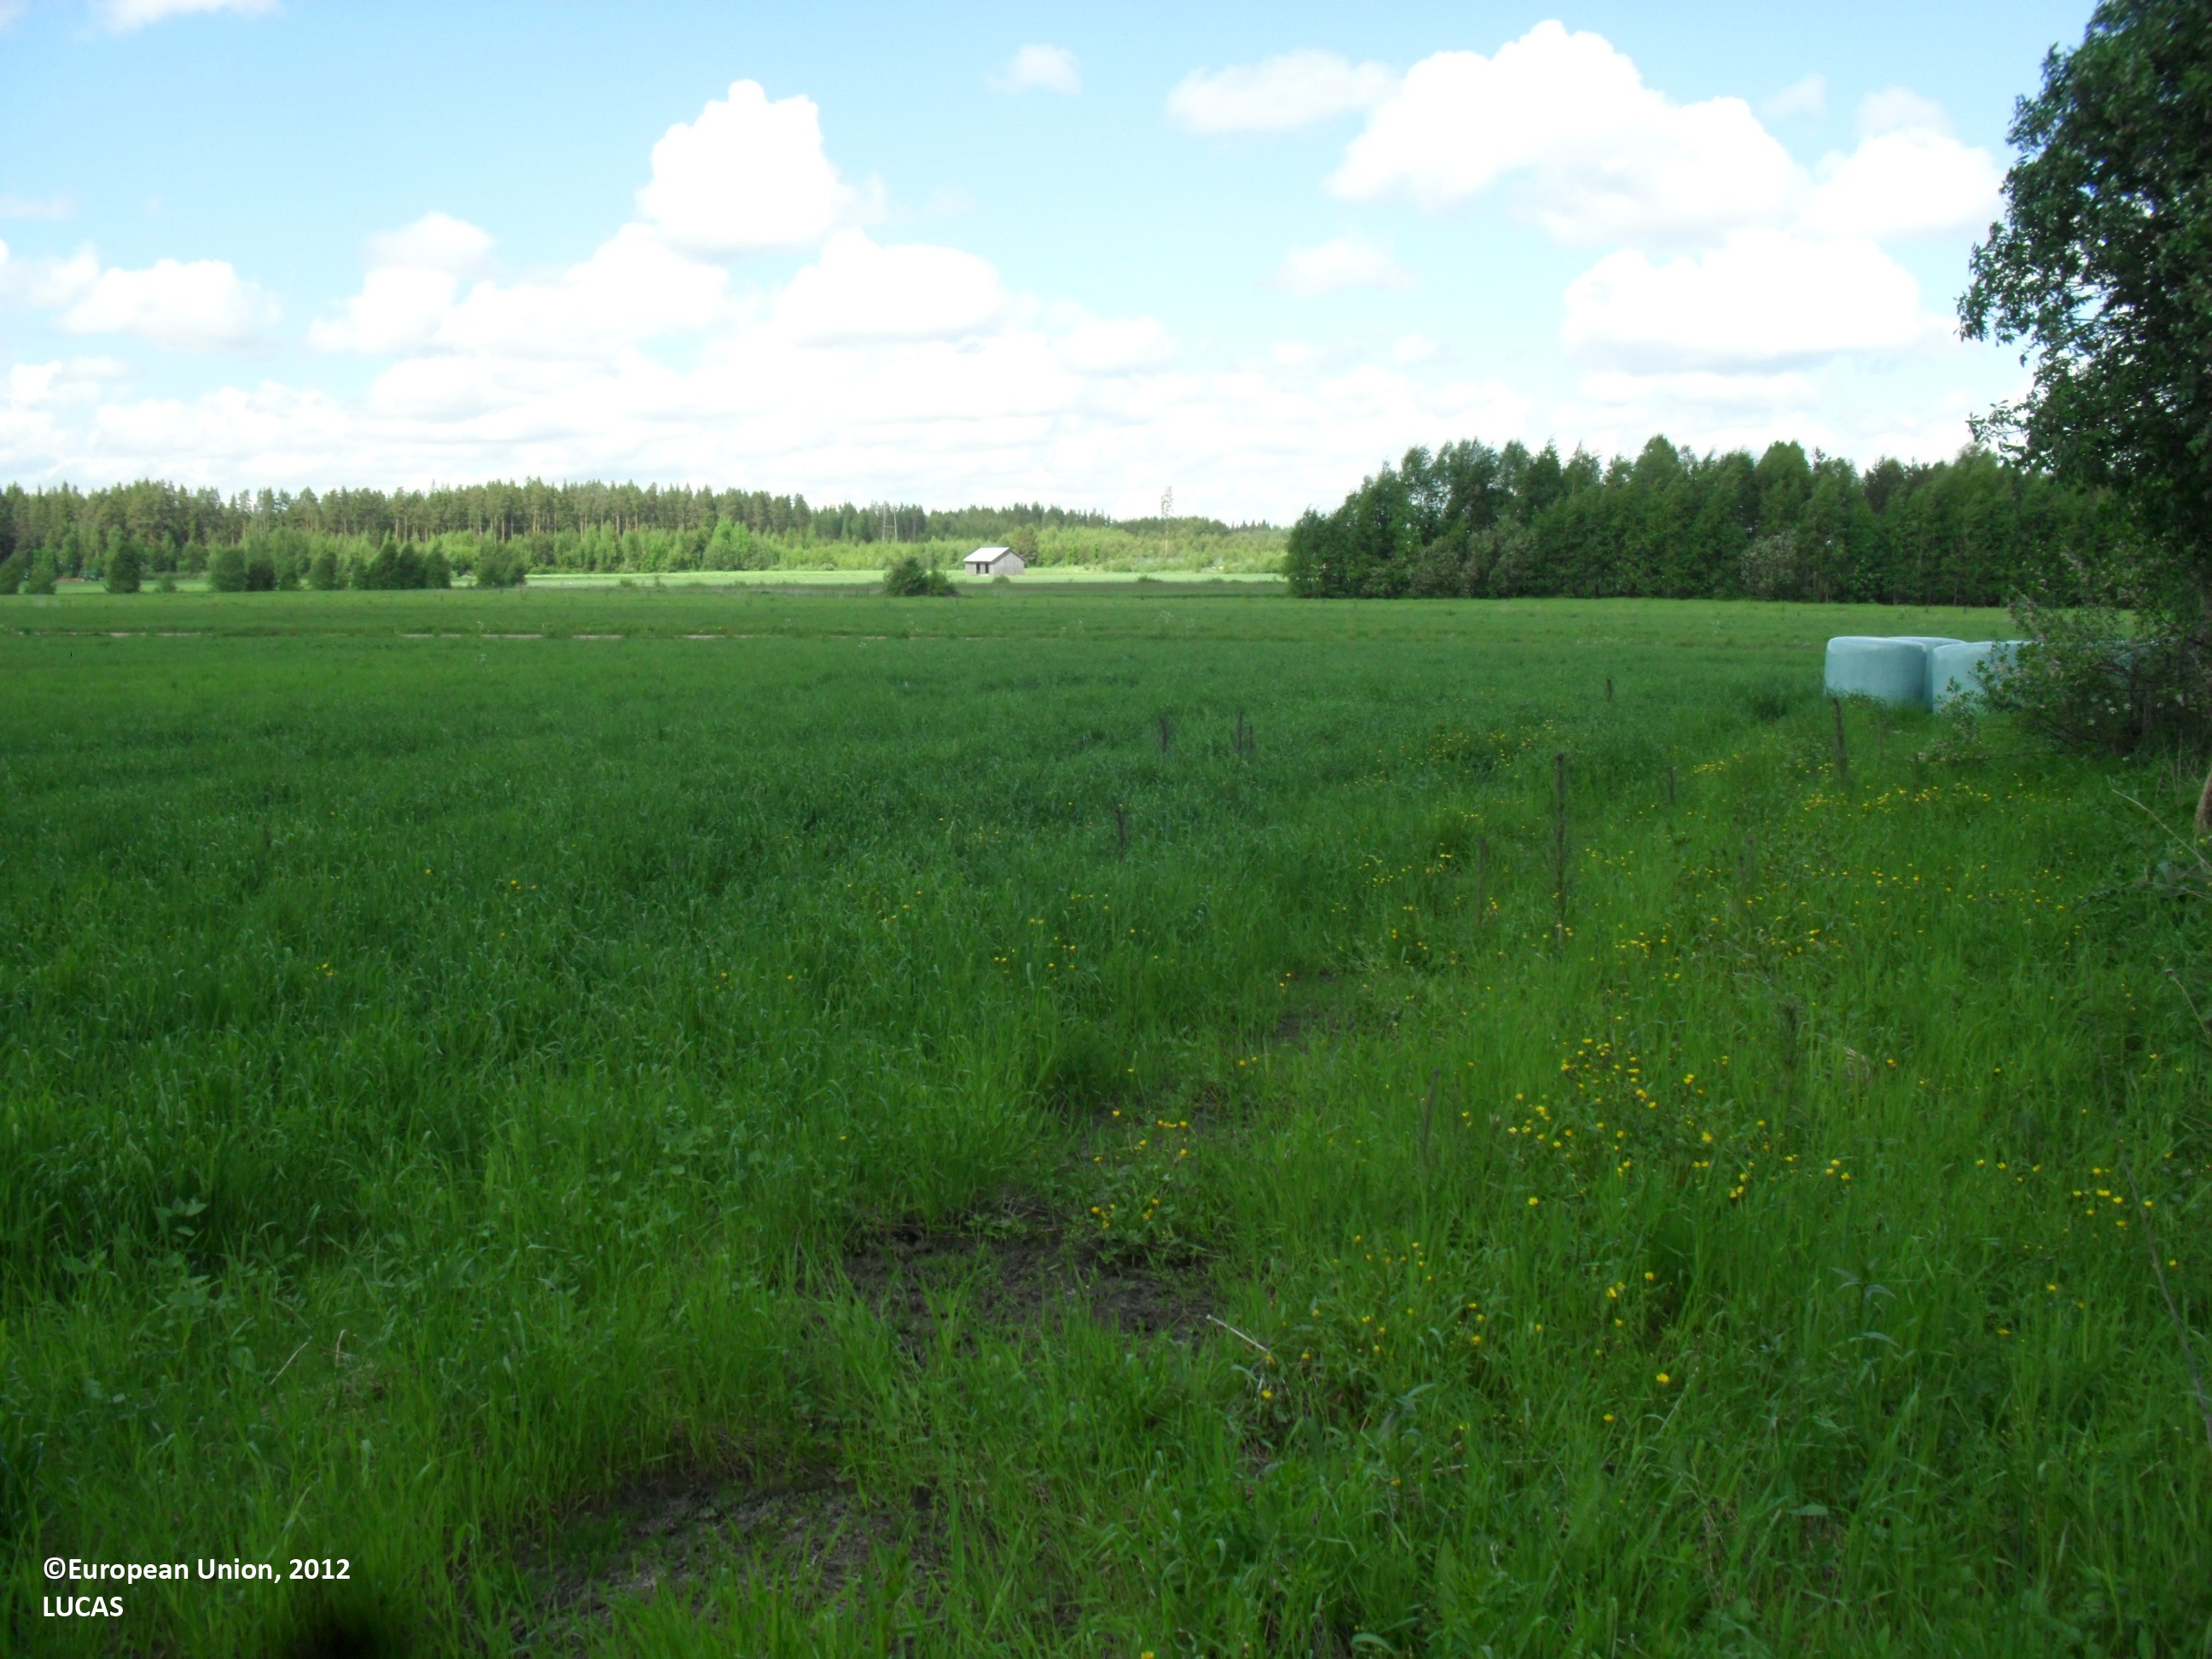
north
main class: Grassland
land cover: Grassland without tree/shrub cover
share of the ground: > 75 %
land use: Agriculture (excluding fallow land and kitchen gardens)
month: June
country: FI
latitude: 62.8218
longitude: 23.5509
